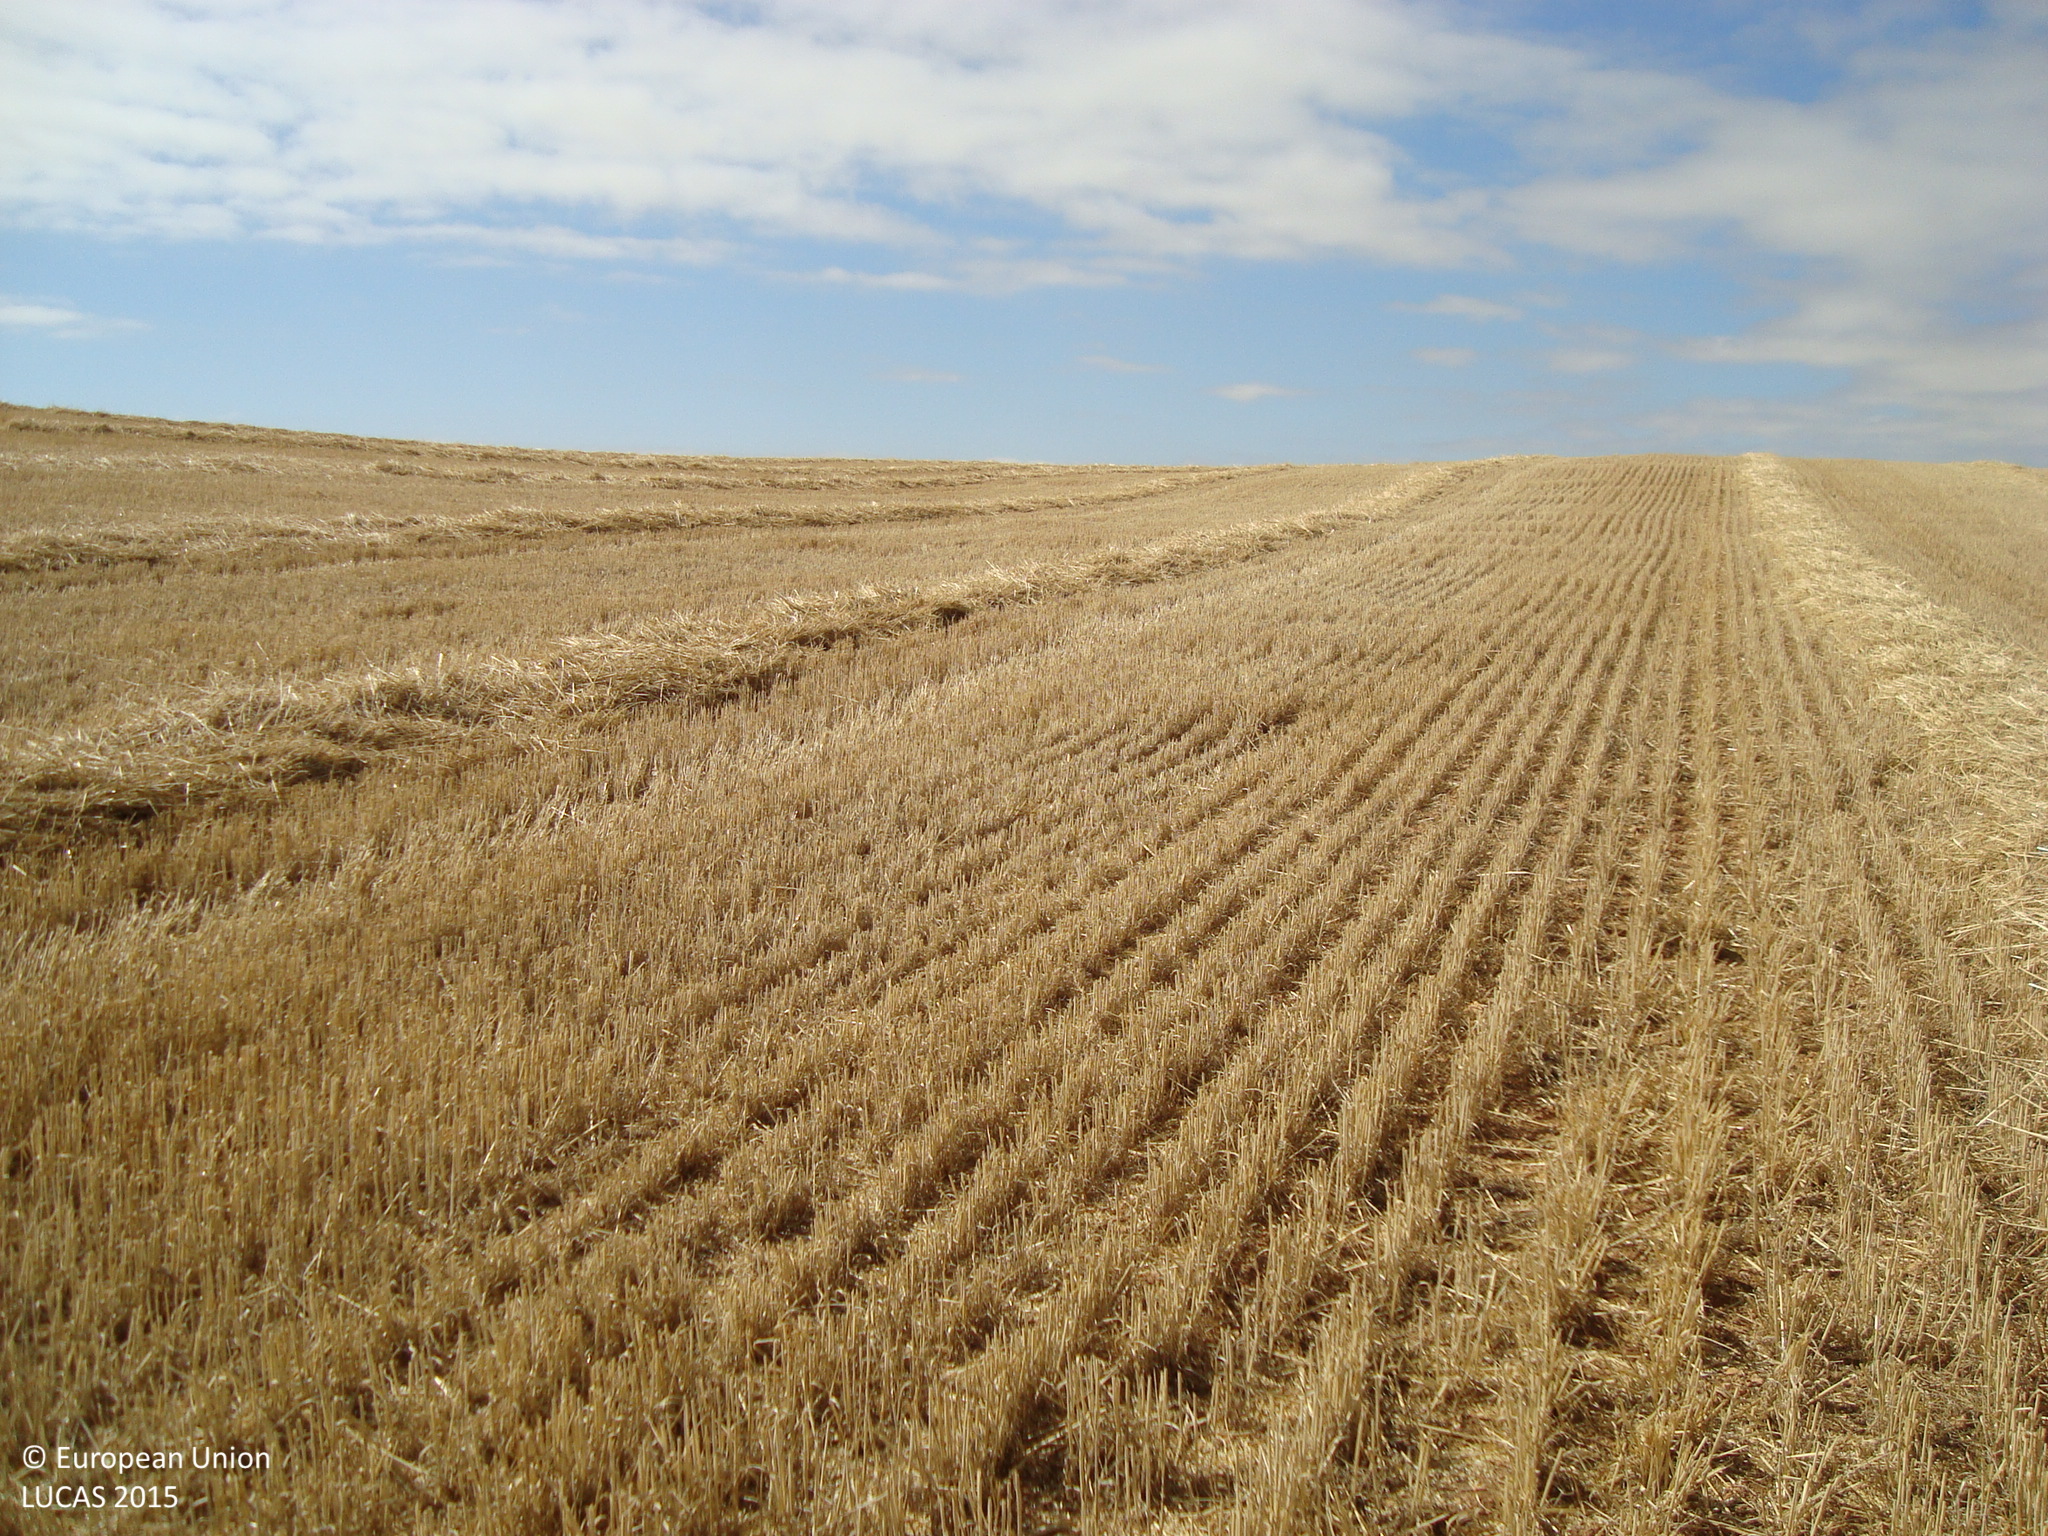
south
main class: Cropland
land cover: Common wheat
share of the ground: > 75 %
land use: Agriculture (excluding fallow land and kitchen gardens)
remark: Harvested field
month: July
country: ES
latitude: 41.9860
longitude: -3.8796
